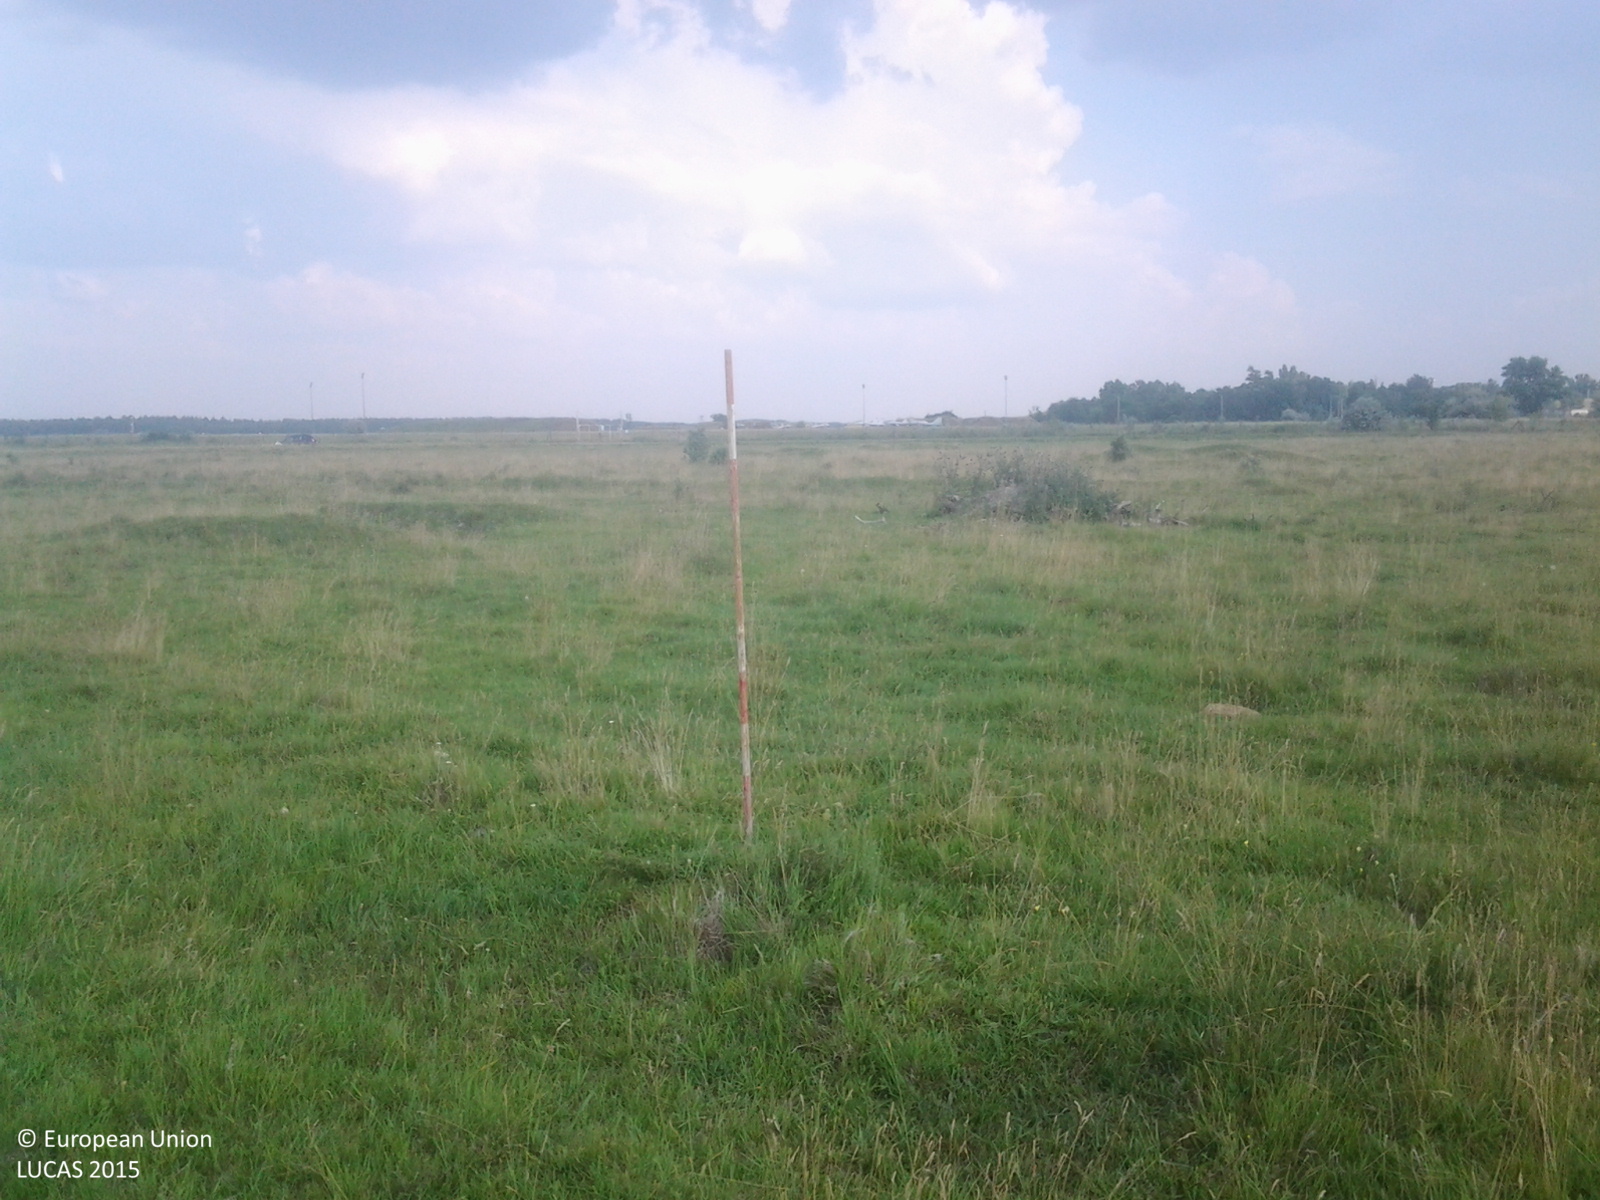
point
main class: Grassland
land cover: Grassland without tree/shrub cover
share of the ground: > 75 %
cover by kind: herbaceous plants 100 %
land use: Agriculture (excluding fallow land and kitchen gardens)
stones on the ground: < 10 %
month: June
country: HU
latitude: 46.9225
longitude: 19.7258
